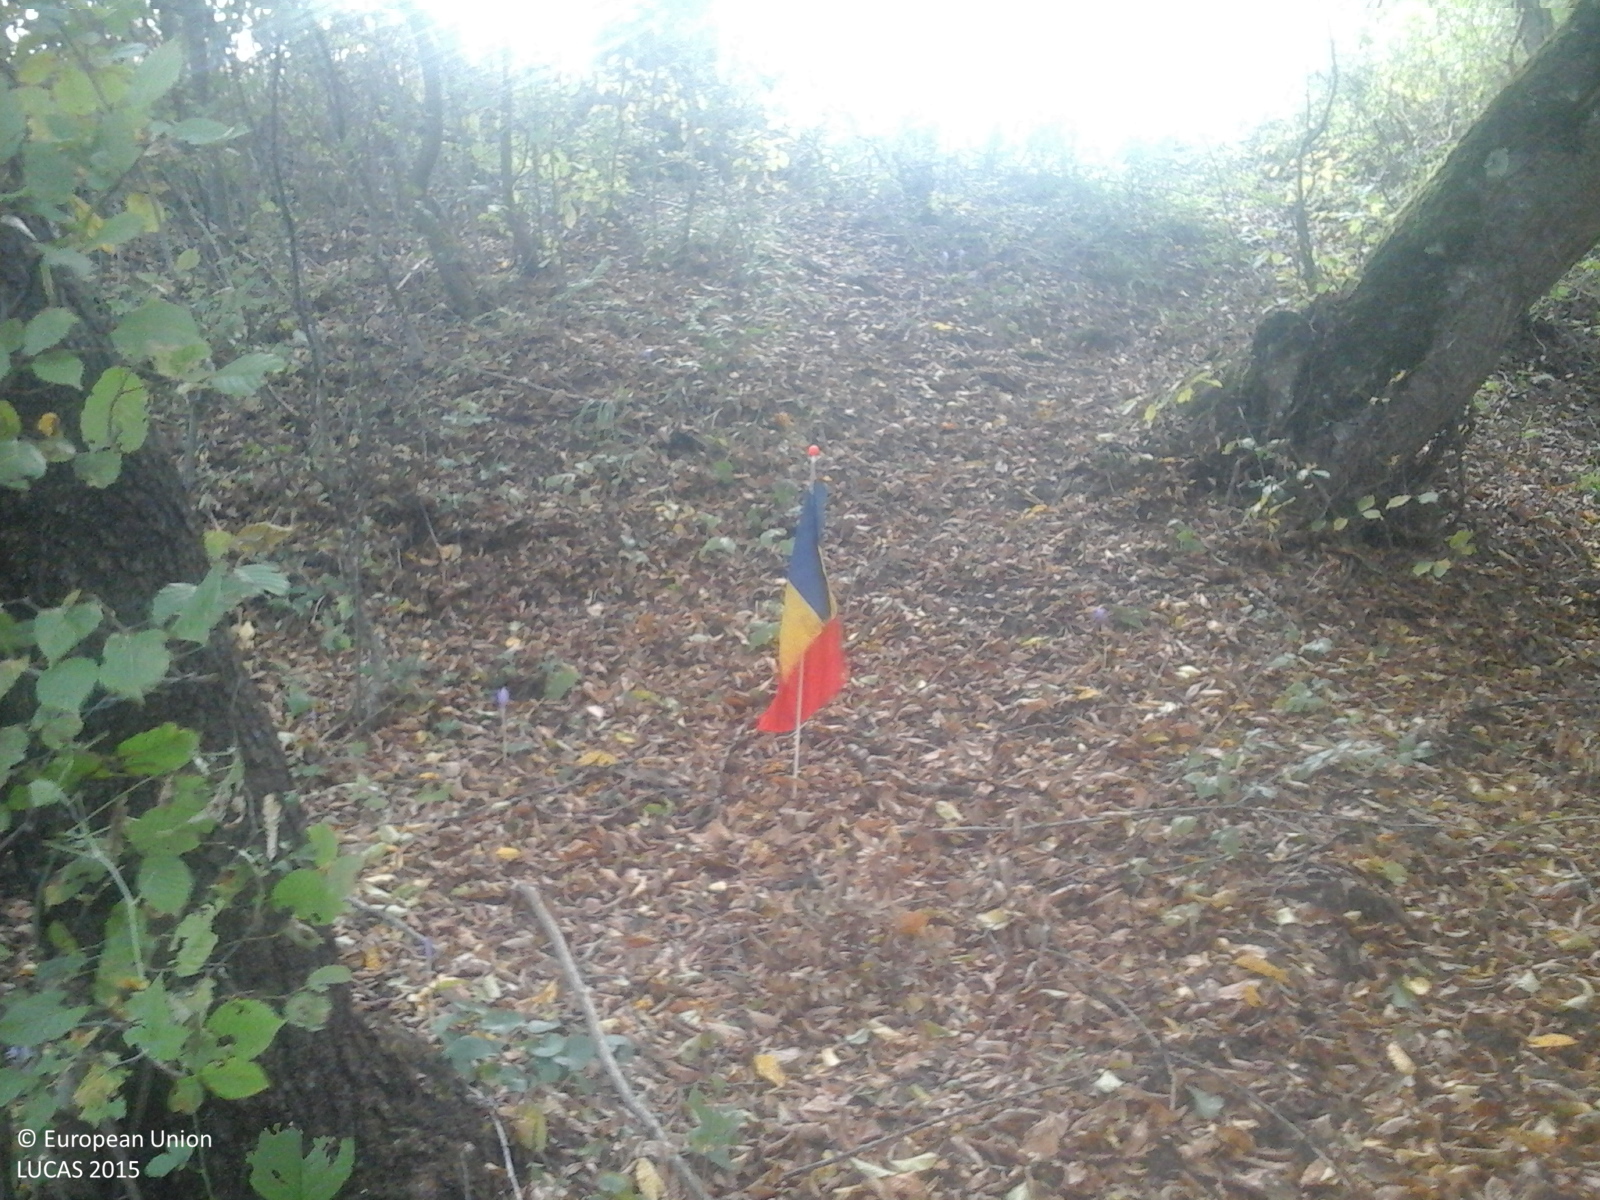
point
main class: Woodland
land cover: Broadleaved woodland
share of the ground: > 75 %
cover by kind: broadleaved forest trees 100 %
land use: Forestry
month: October
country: RO
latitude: 46.1234
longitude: 25.4134
